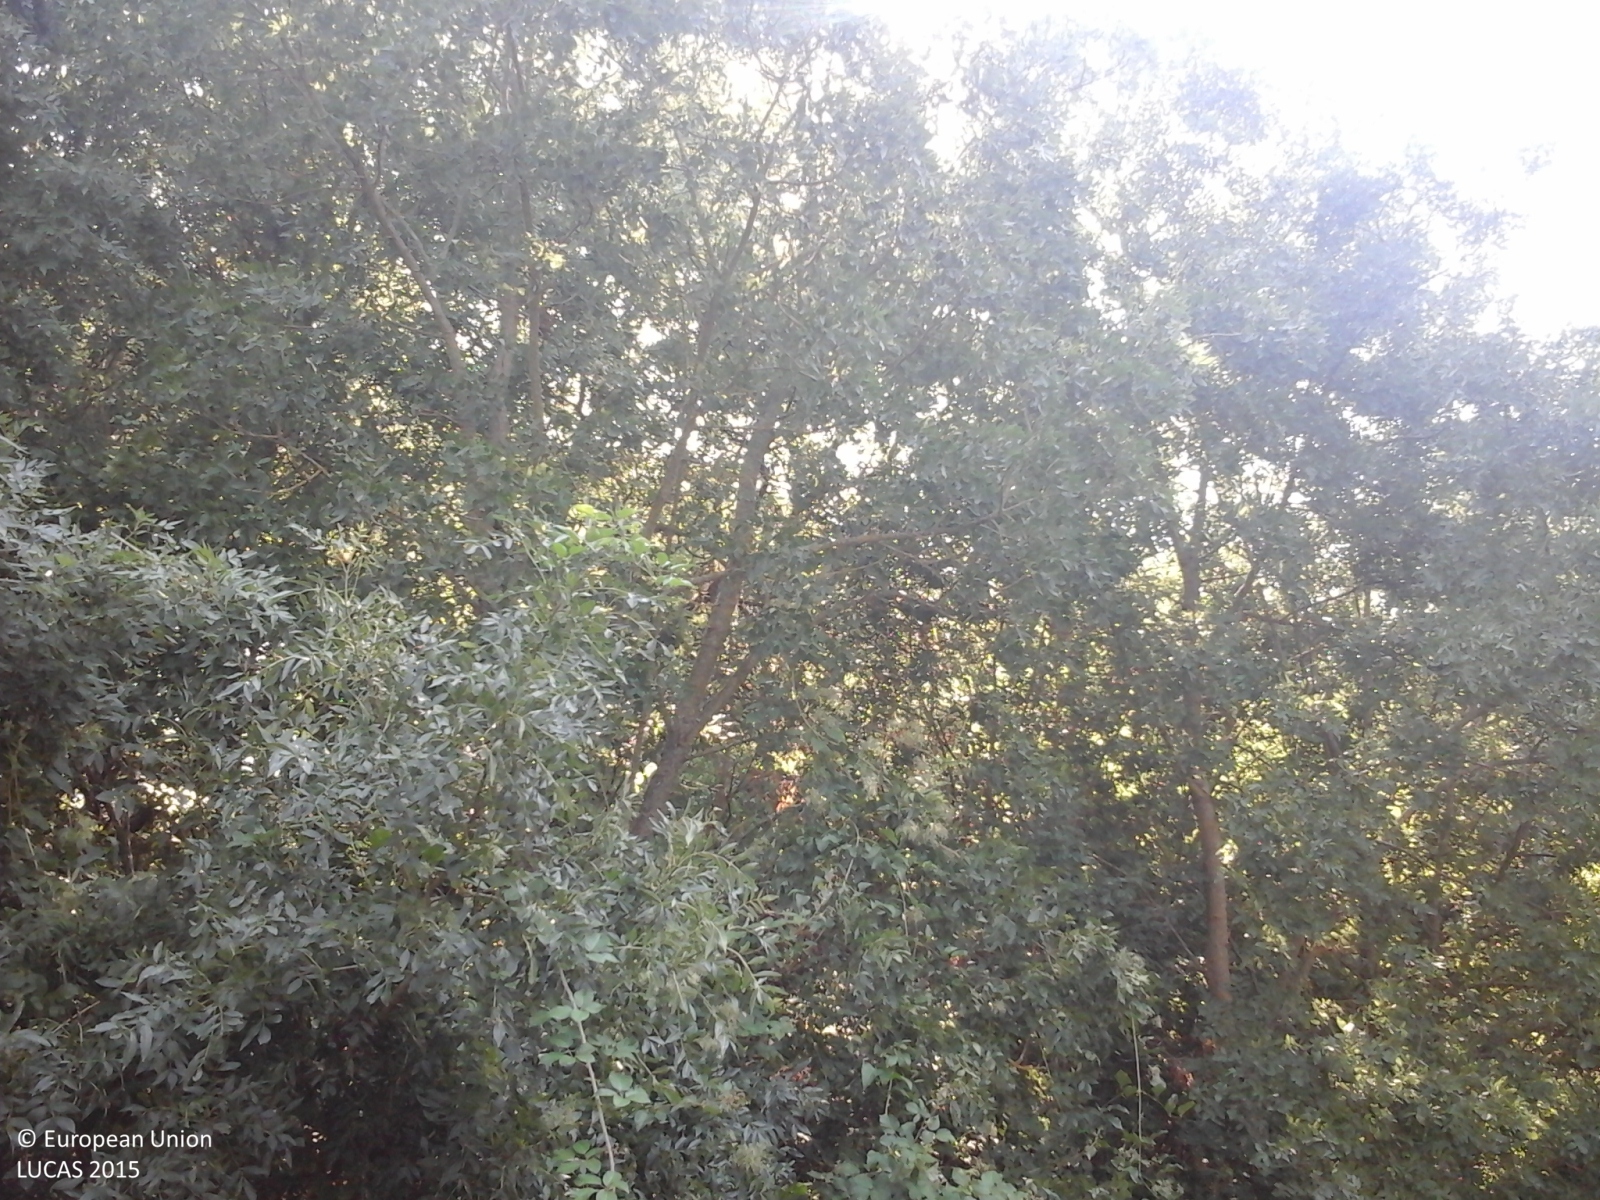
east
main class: Woodland
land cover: Broadleaved woodland
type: thermophilous deciduous forest
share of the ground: > 75 %
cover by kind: broadleaved forest trees 80 %, shrubs 15 %, herbaceous plants 5 %
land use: Forestry
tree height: > 5 m
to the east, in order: Broadleaved woodland
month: August
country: IT
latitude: 41.3484
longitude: 15.1093
